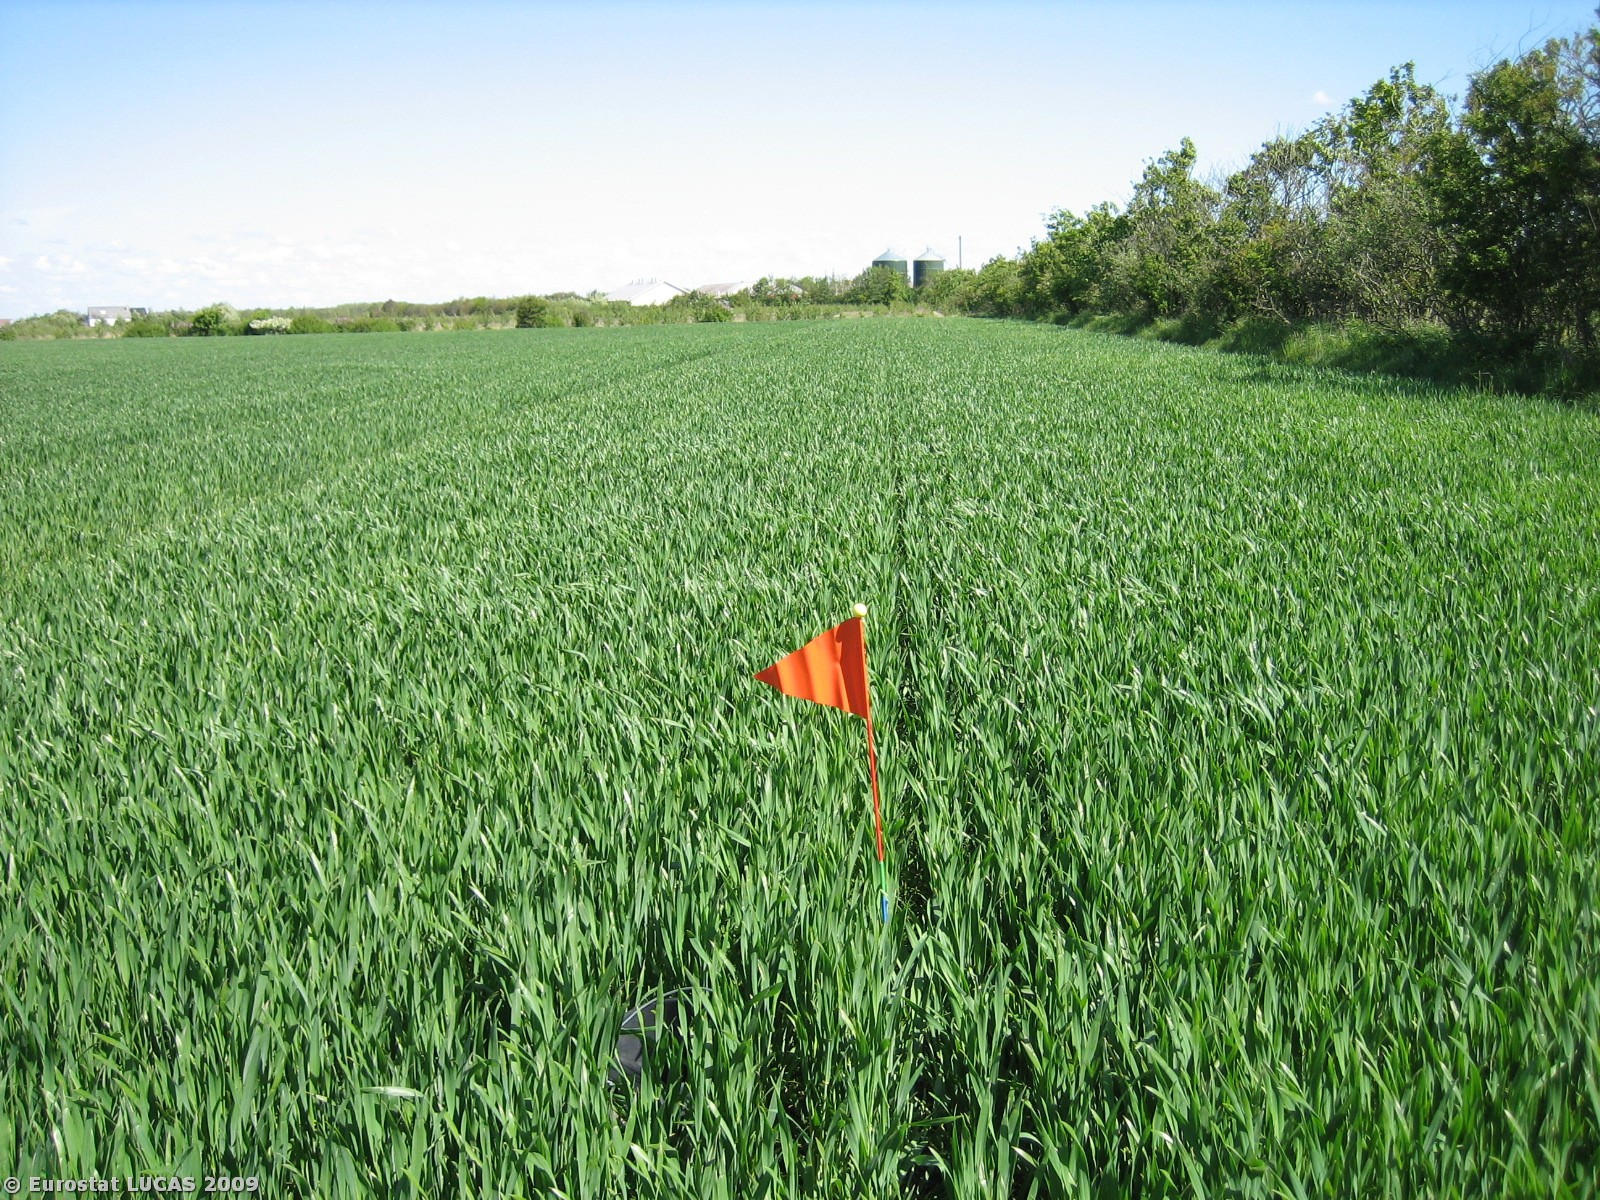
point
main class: Cropland
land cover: Common wheat
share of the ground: > 75 %
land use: Agriculture (excluding fallow land and kitchen gardens)
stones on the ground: < 10 %
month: May
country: DK
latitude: 55.9443
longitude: 8.4165
